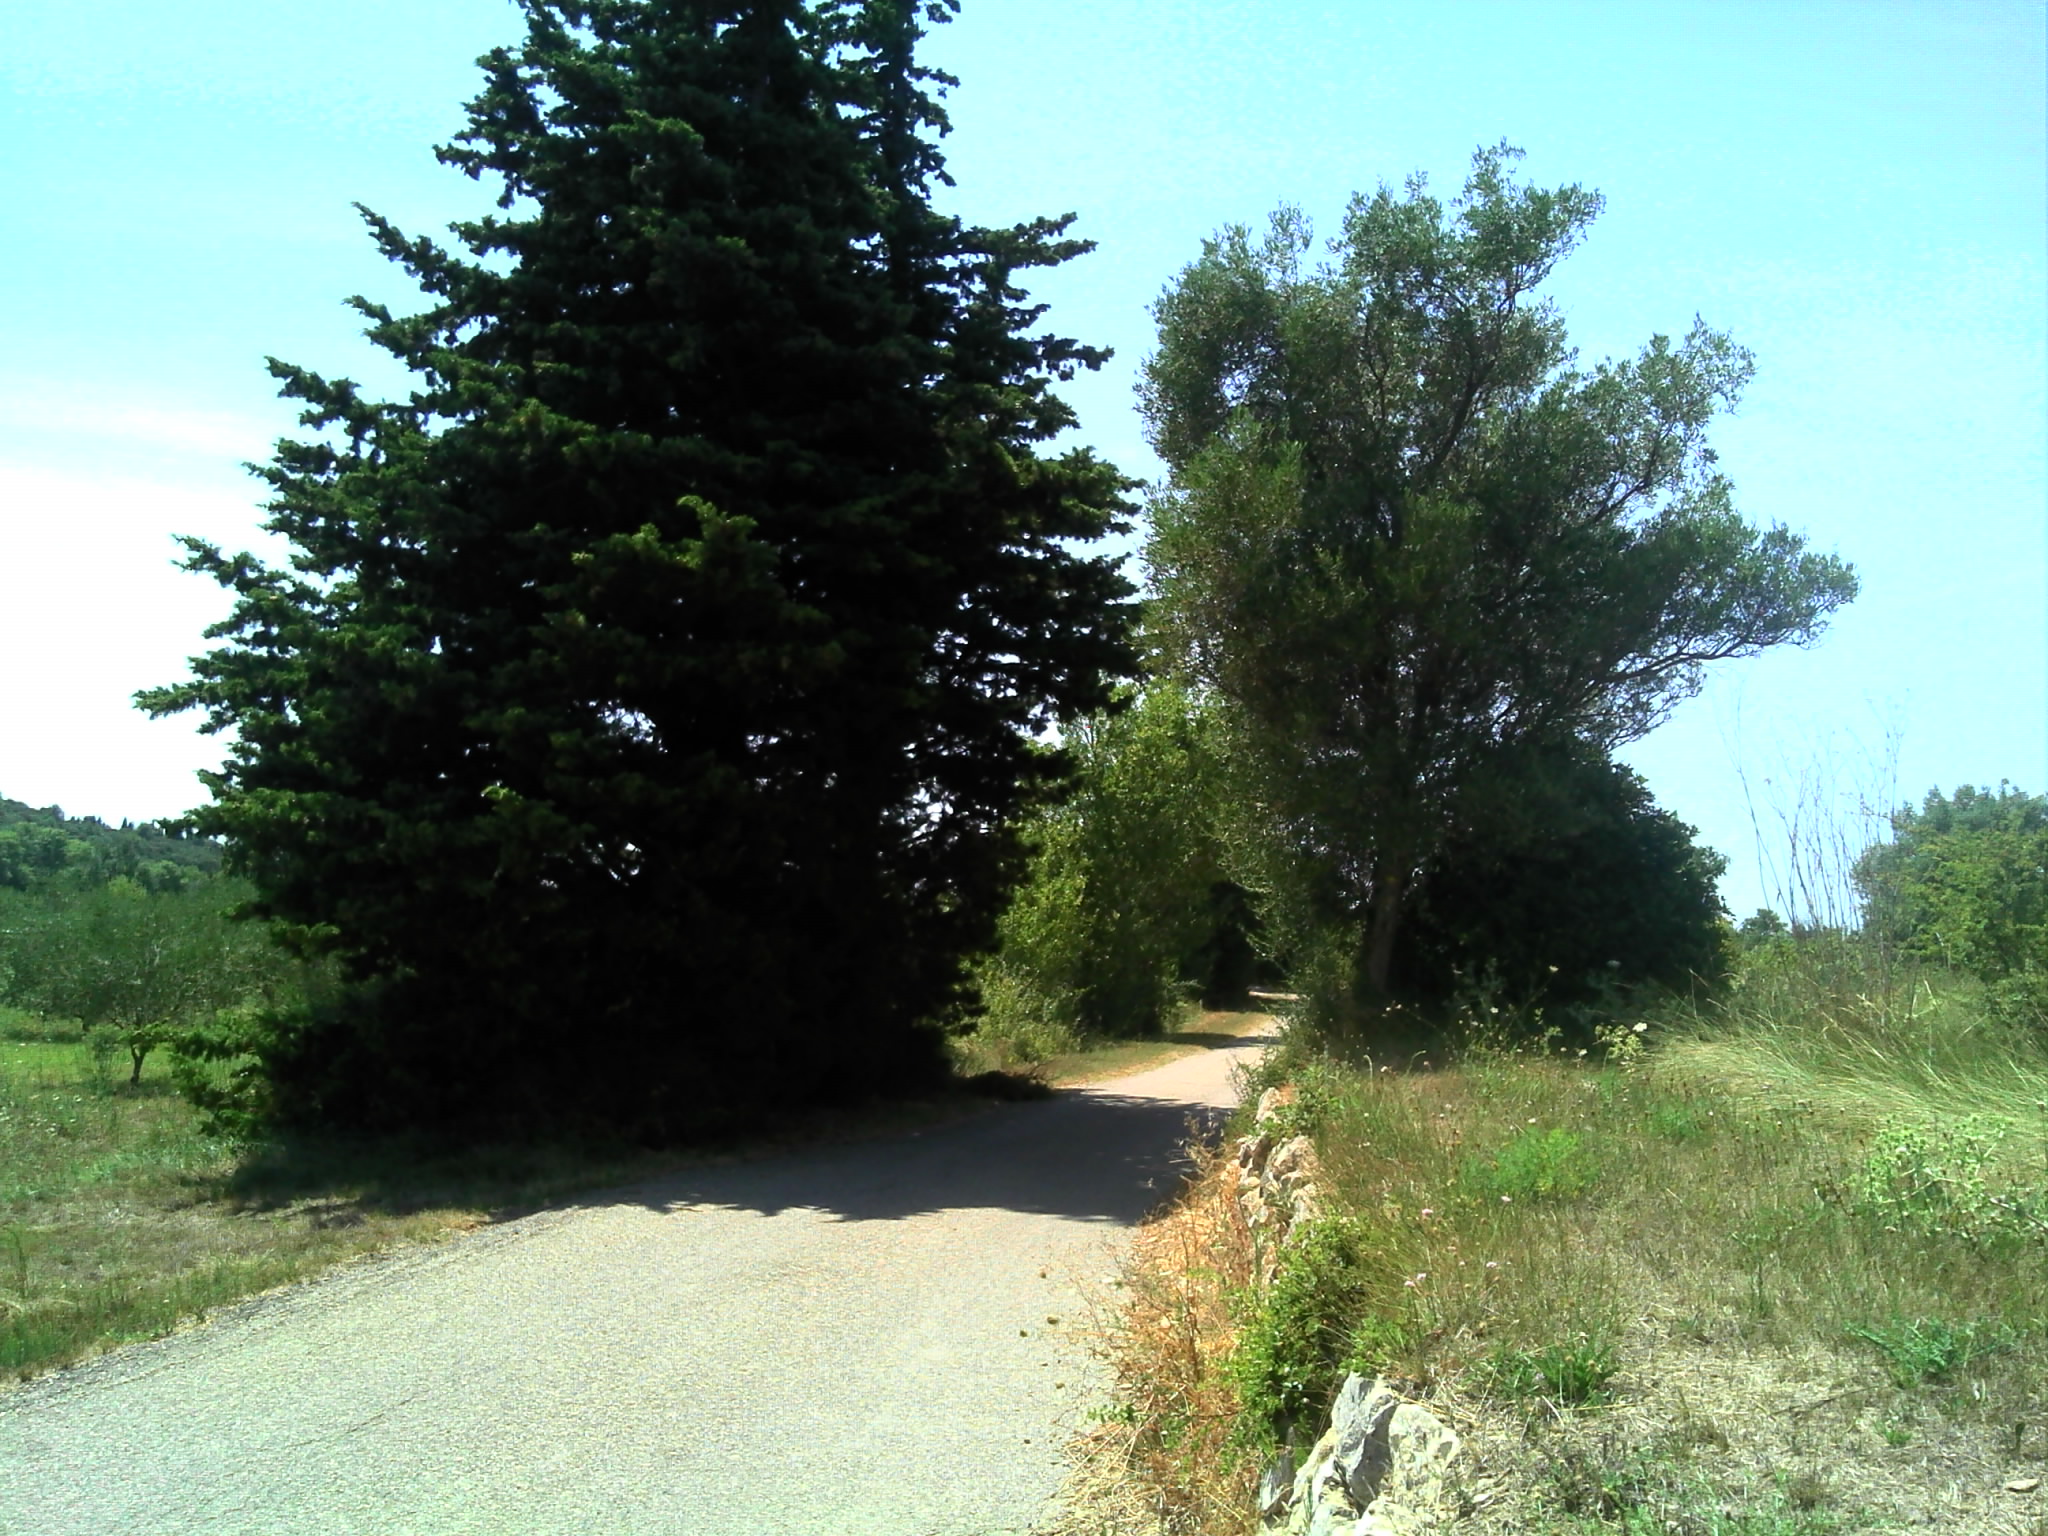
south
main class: Shrubland
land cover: Shrubland with sparse tree cover
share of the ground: > 75 %
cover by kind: herbaceous plants 50 %, shrubs 40 %, broadleaved forest trees 5 %, consolidated bare surface 5 %
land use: Semi-natural and natural areas not in use
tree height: < 5 m
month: August
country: FR
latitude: 43.9062
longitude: 4.6671
